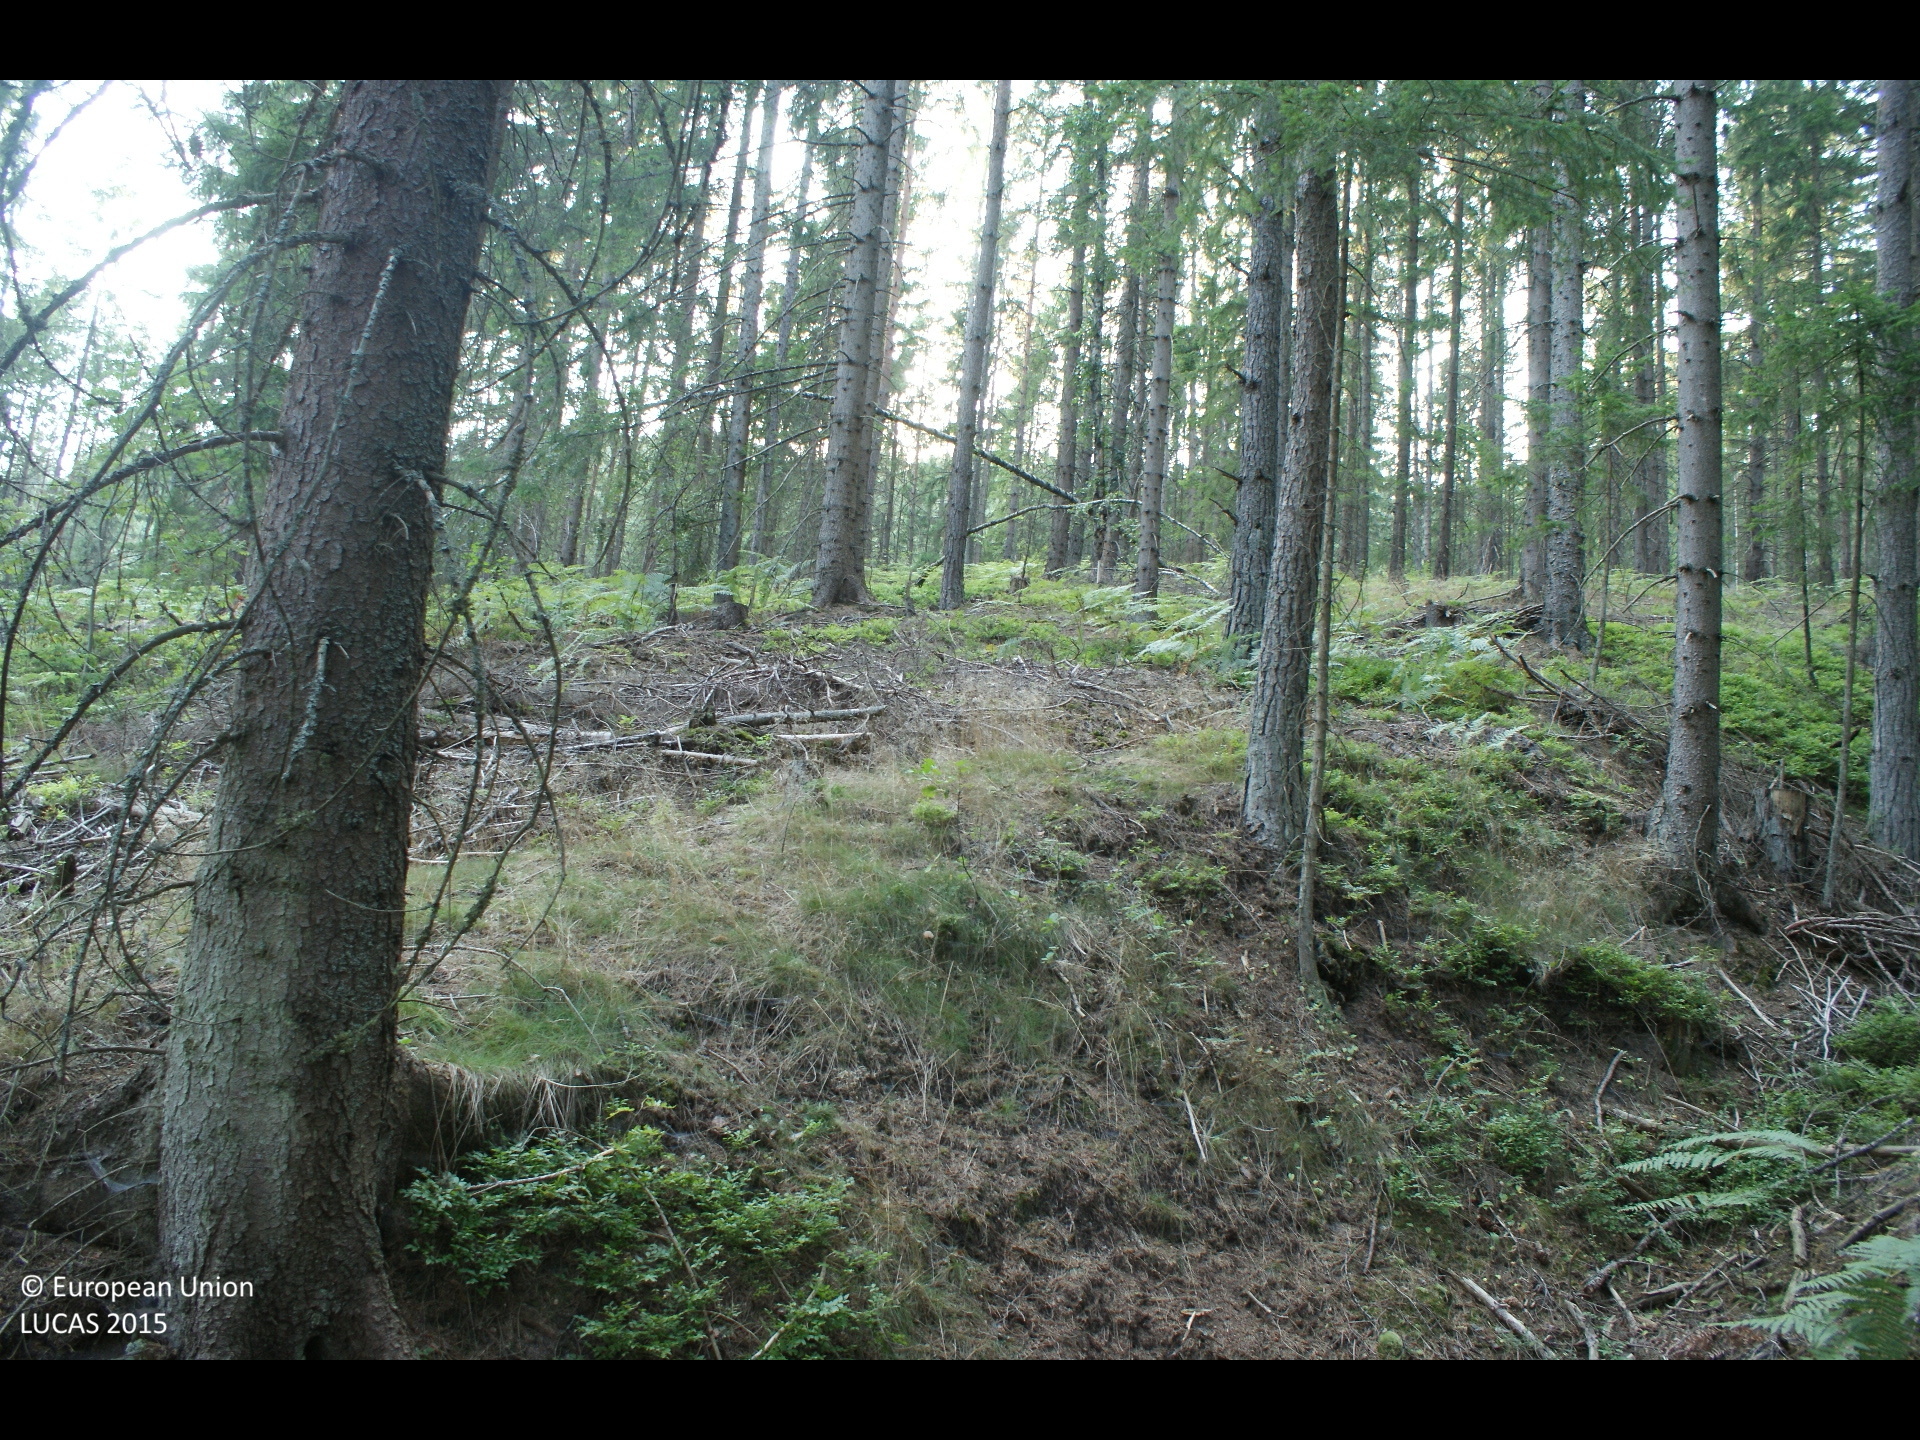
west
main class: Woodland
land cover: Spruce dominated coniferous woodland
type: alpine coniferous forest
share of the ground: > 75 %
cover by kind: coniferous forest trees 80 %, shrubs 10 %, herbaceous plants 5 %, unconsolidated bare surface 5 %
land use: Forestry
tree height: > 5 m
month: August
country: AT
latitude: 47.4972
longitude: 15.3768
